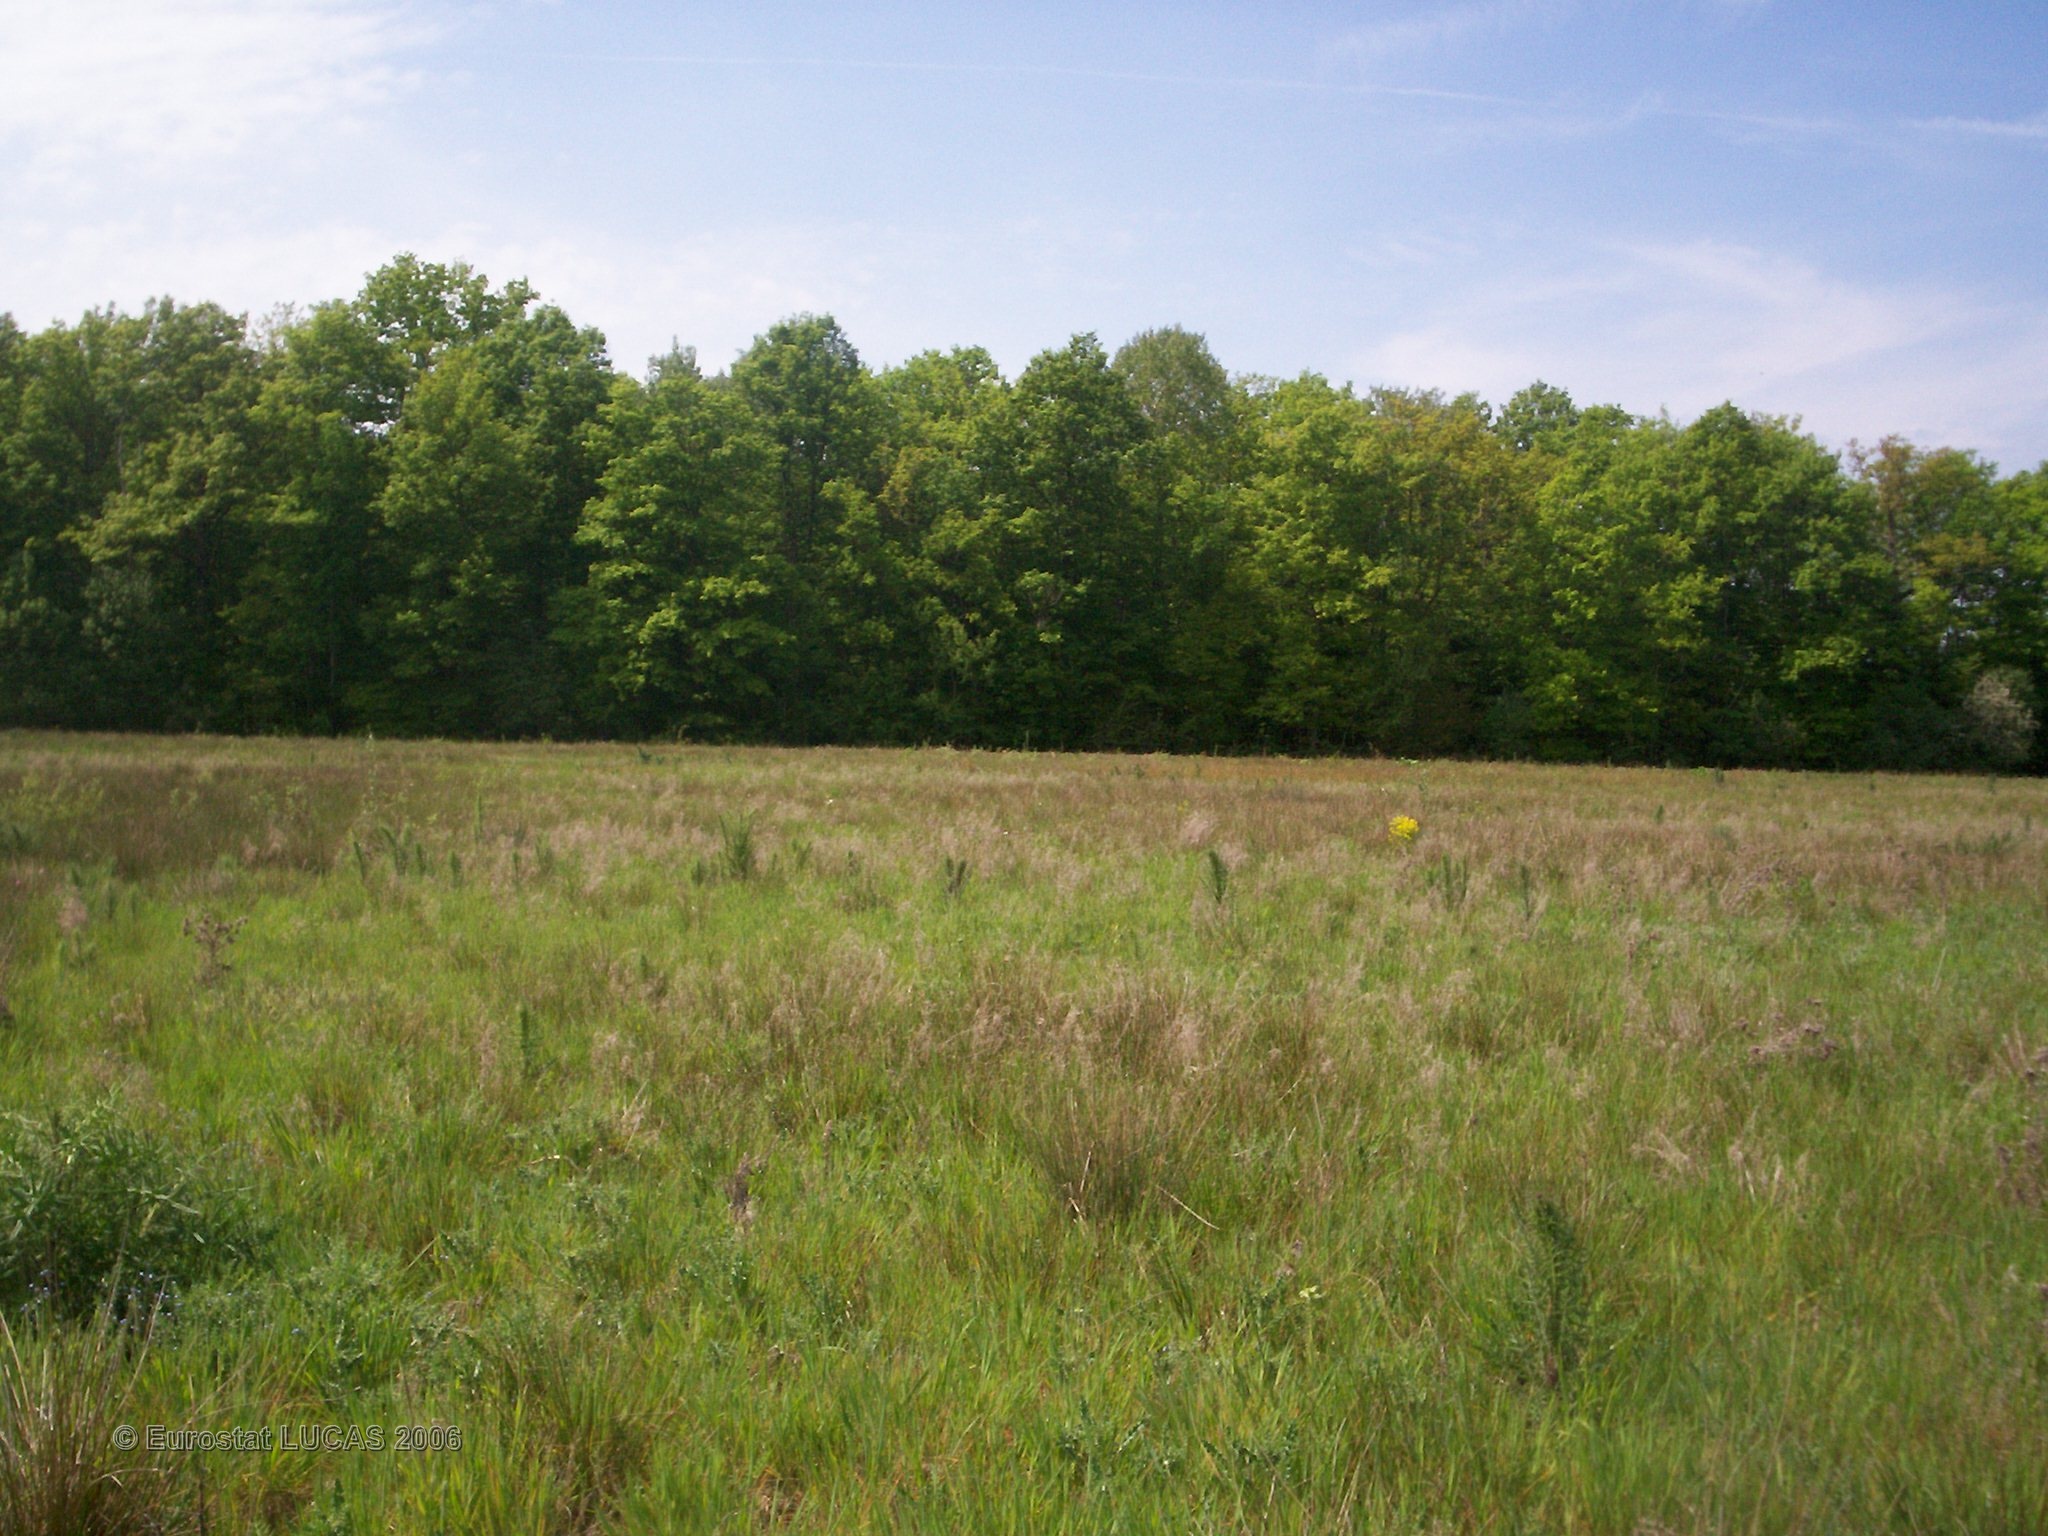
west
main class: Grassland
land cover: Grassland without tree/shrub cover
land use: Agriculture (excluding fallow land and kitchen gardens)
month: May
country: FR
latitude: 47.6384
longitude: 2.9794
